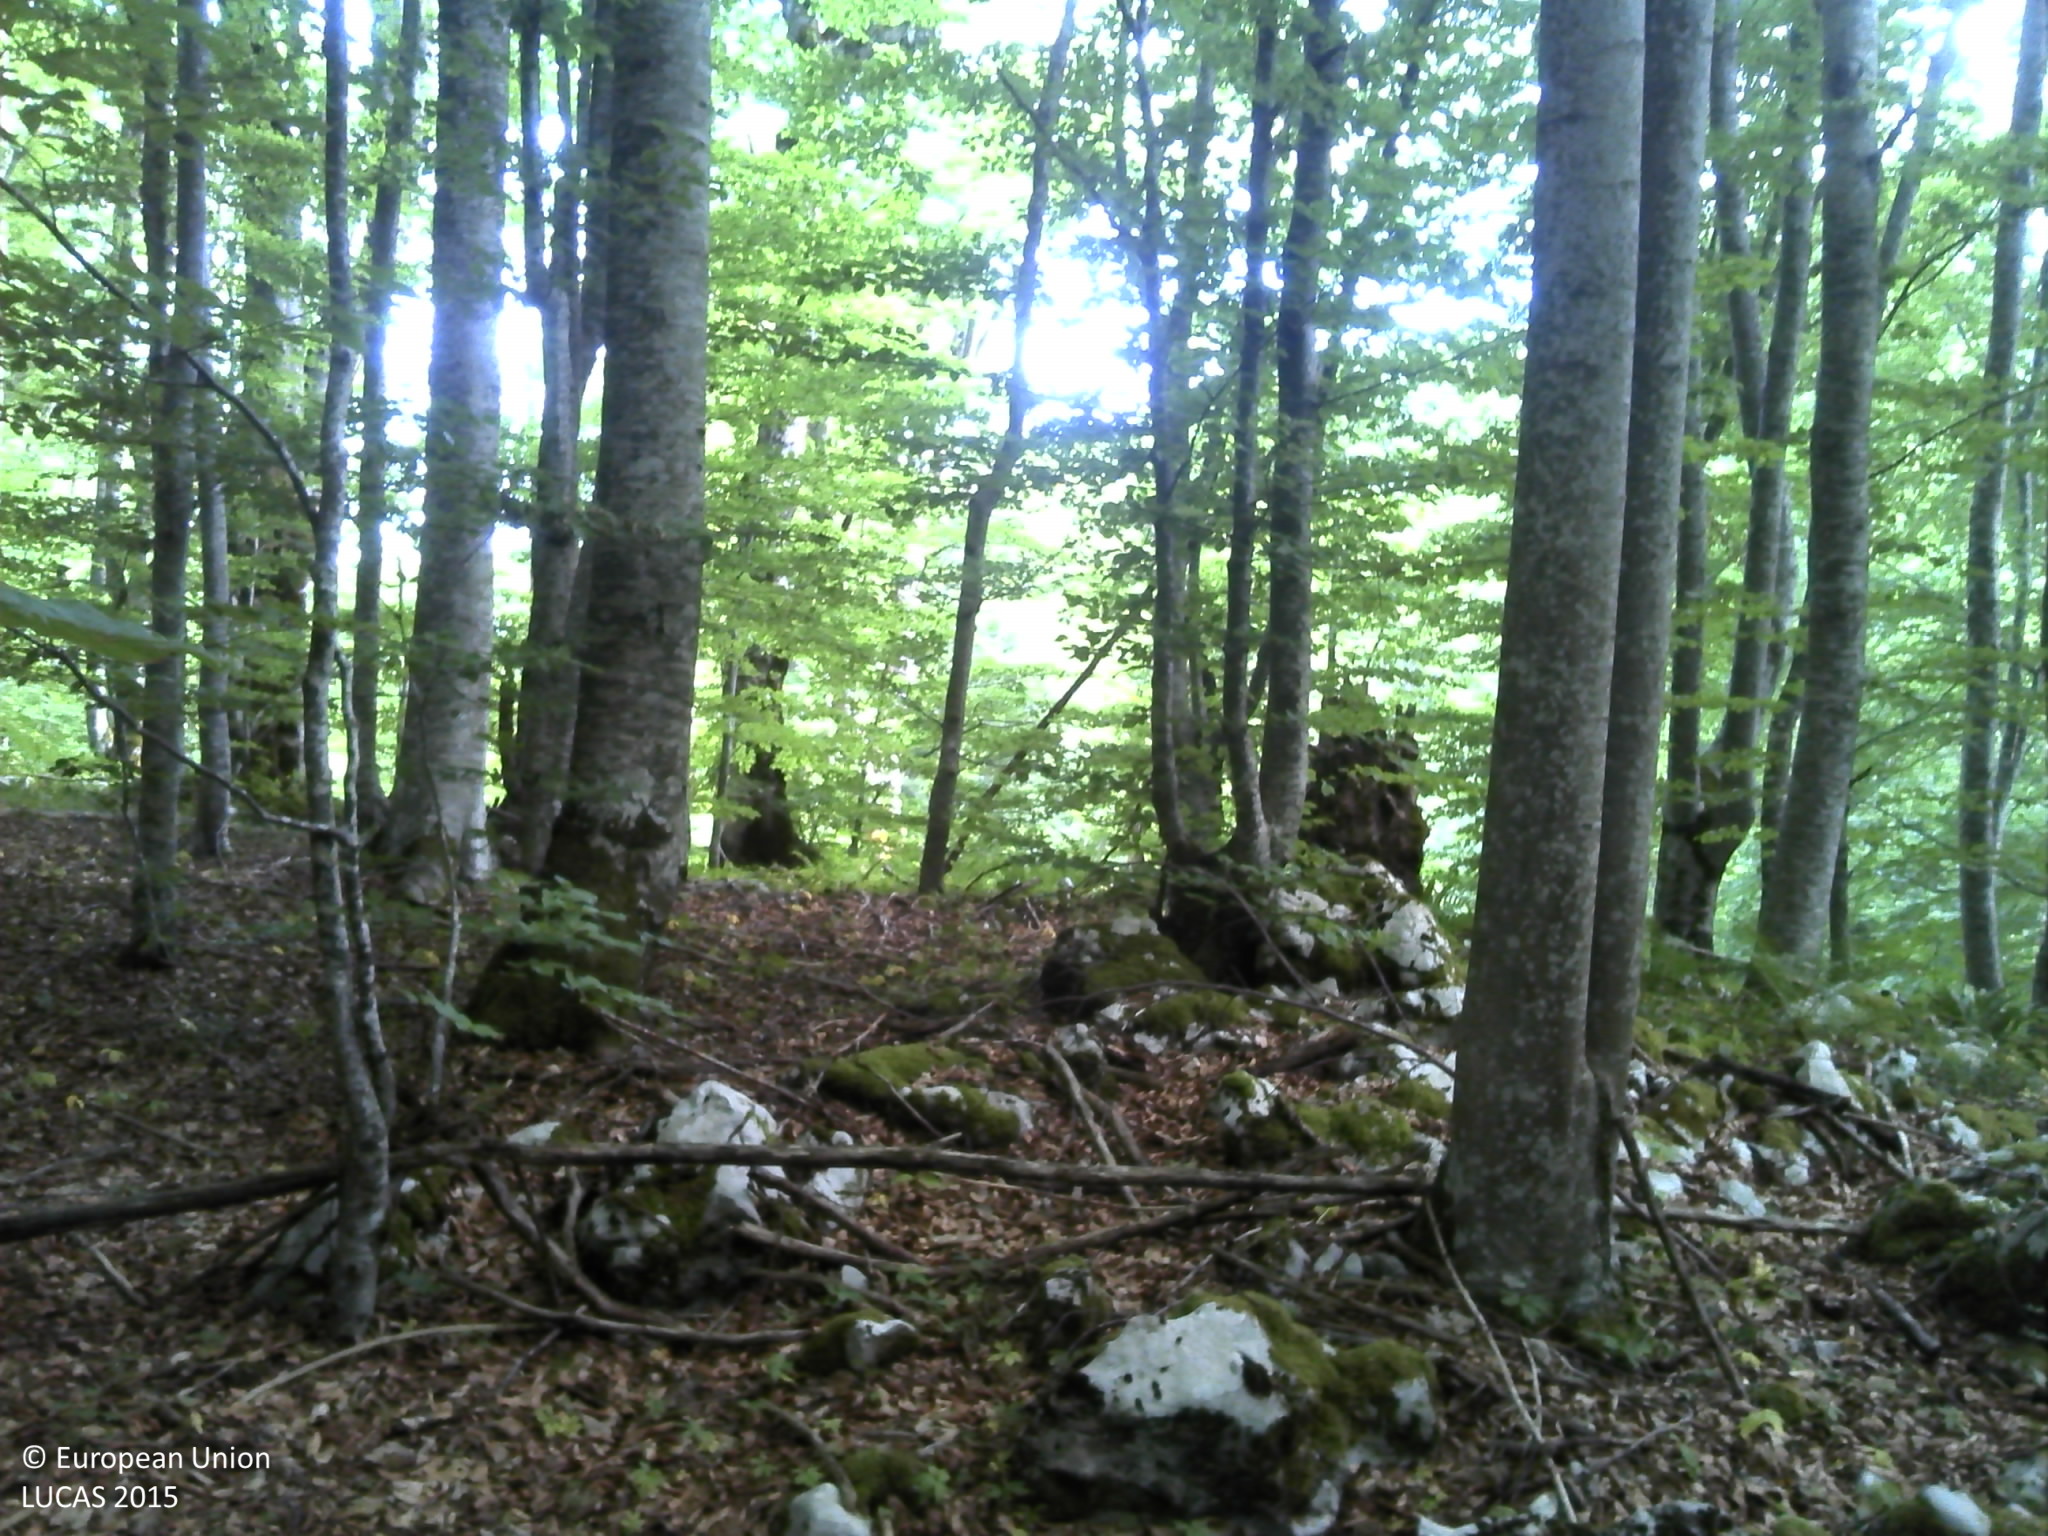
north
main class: Woodland
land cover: Broadleaved woodland
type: mountainous beech forest
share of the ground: > 75 %
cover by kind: broadleaved forest trees 90 %, consolidated bare surface 10 %
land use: Forestry
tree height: > 5 m
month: June
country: HR
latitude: 44.5983
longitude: 15.9026
